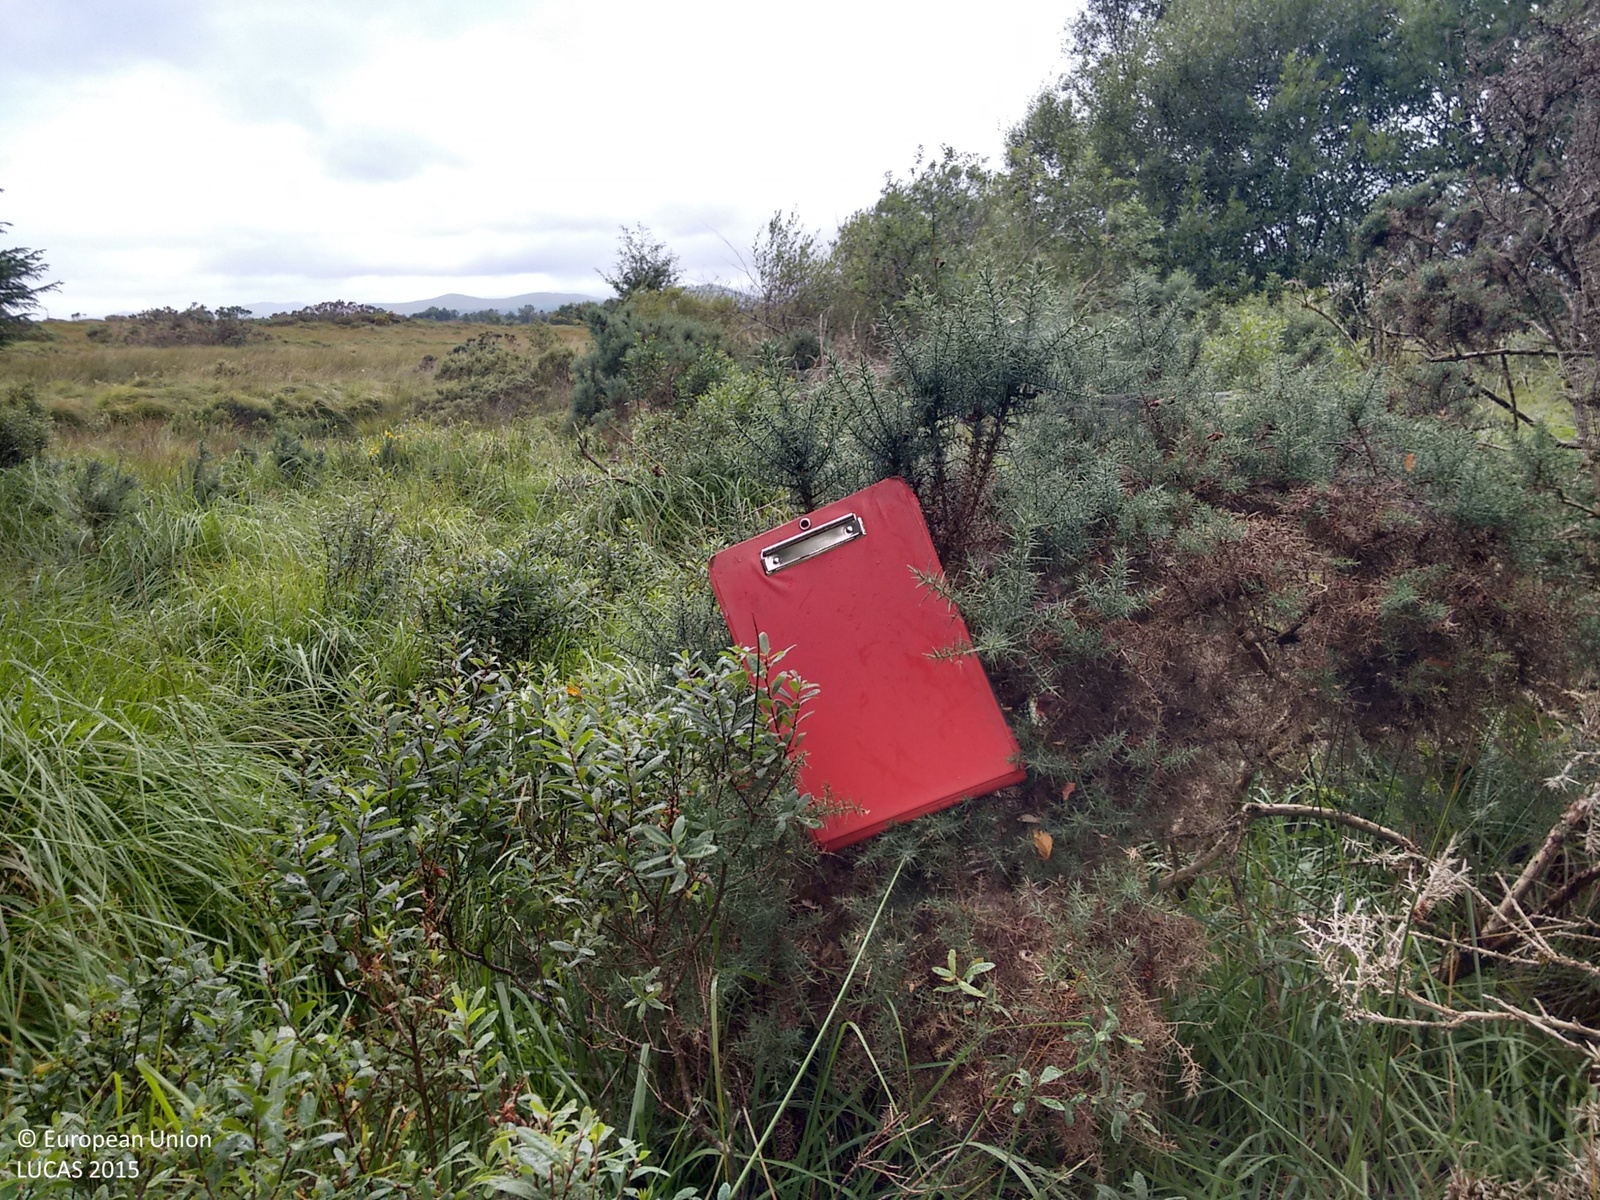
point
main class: Shrubland
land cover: Shrubland with sparse tree cover
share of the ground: > 75 %
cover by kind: shrubs 55 %, herbaceous plants 40 %, broadleaved forest trees 5 %
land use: Forestry
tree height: > 5 m
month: August
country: IE
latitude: 51.8832
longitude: -9.5120
